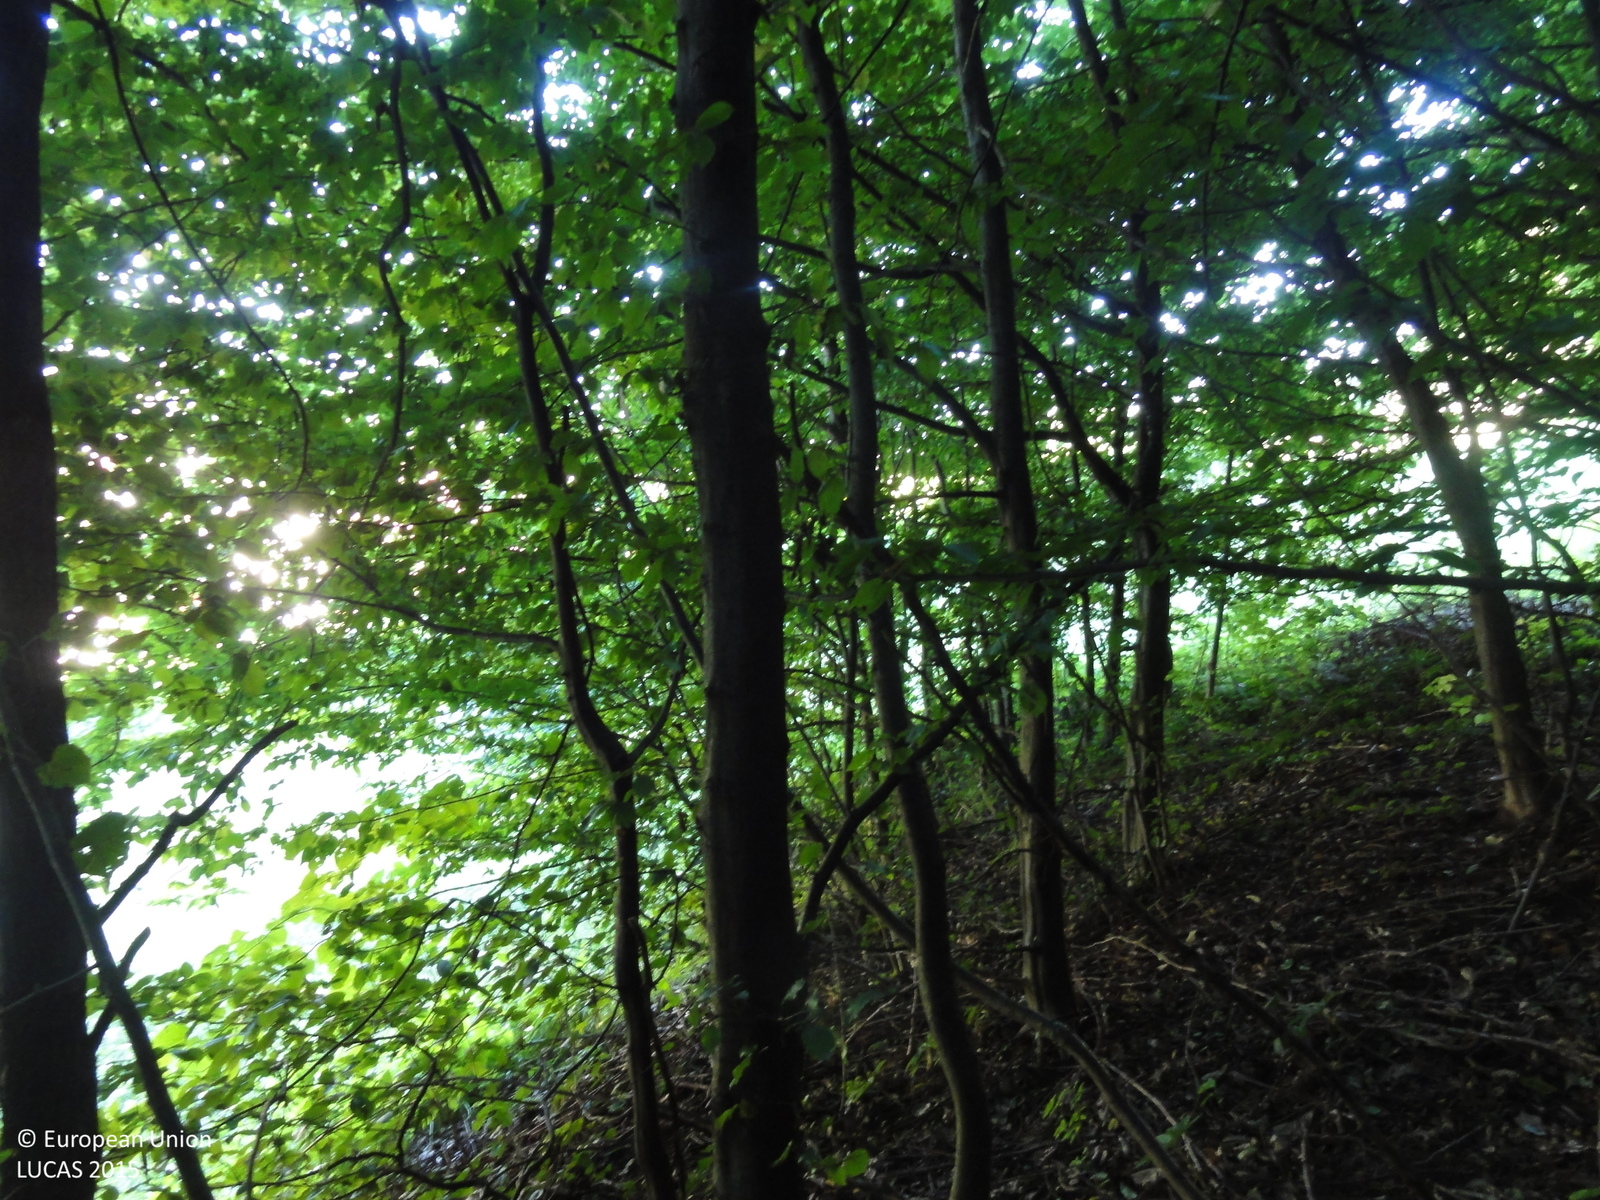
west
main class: Woodland
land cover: Broadleaved woodland
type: mesophytic deciduous forest
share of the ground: > 75 %
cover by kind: broadleaved forest trees 100 %
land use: Forestry
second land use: Amenities, museums, leisure
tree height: > 5 m
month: July
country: SI
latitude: 46.3222
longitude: 15.0499
